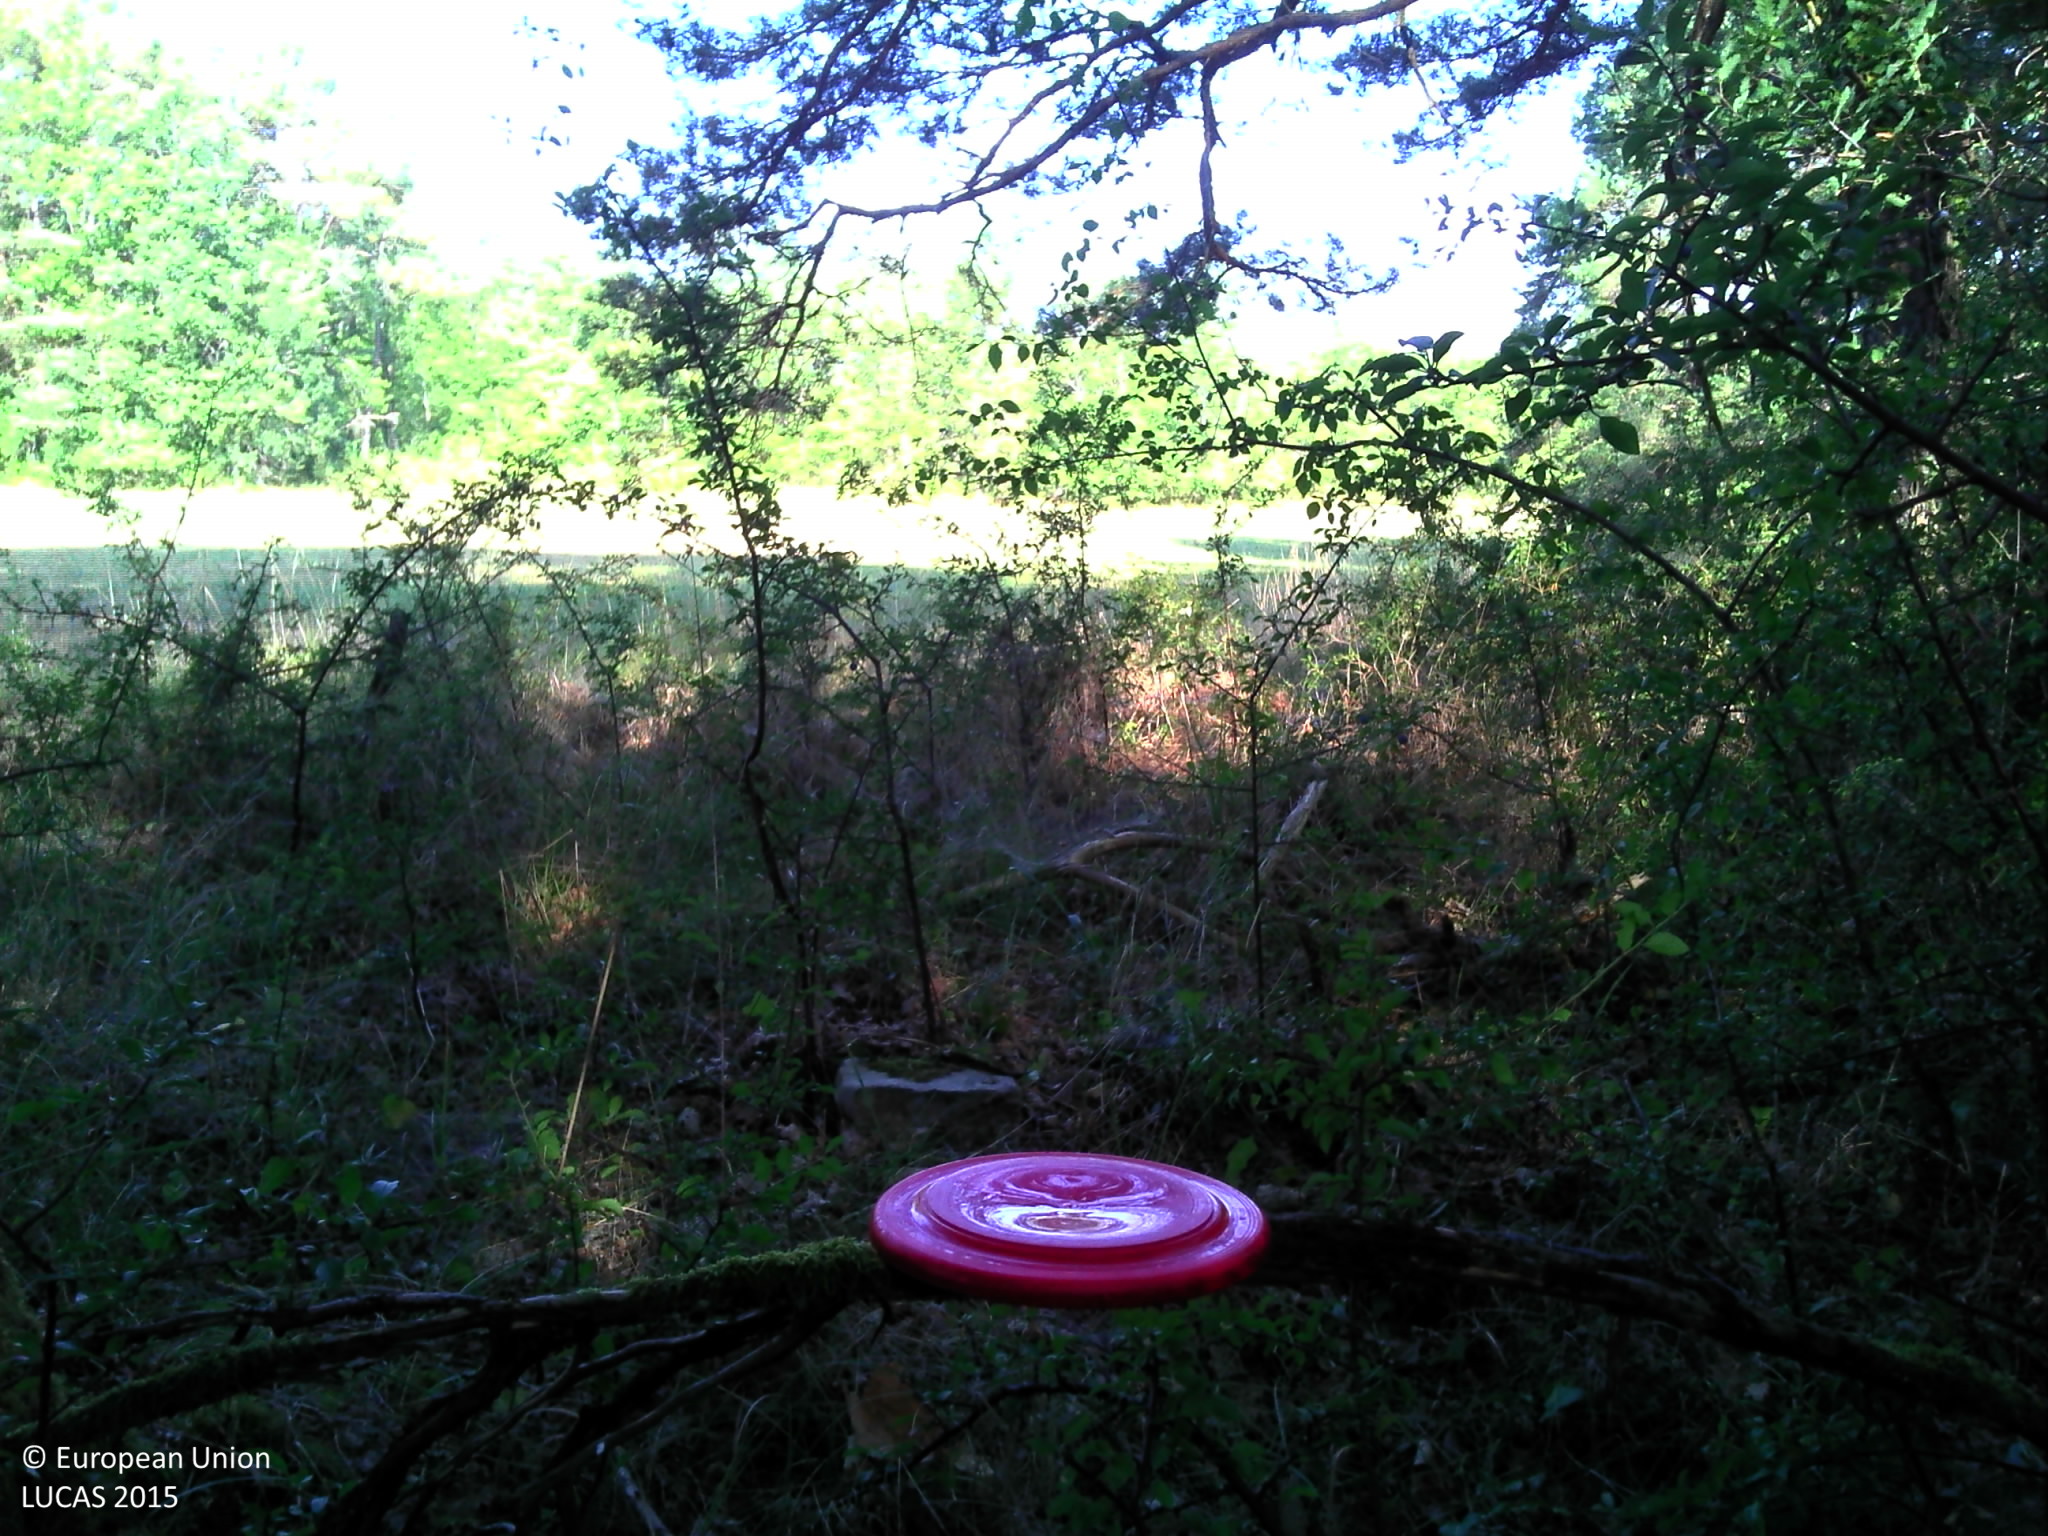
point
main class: Woodland
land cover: Broadleaved woodland
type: acidophilous oak and oak-birch forest
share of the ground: > 75 %
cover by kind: broadleaved forest trees 75 %, herbaceous plants 15 %, coniferous forest trees 5 %, shrubs 5 %
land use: Forestry
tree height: > 5 m
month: July
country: FR
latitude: 45.2514
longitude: 1.0602
